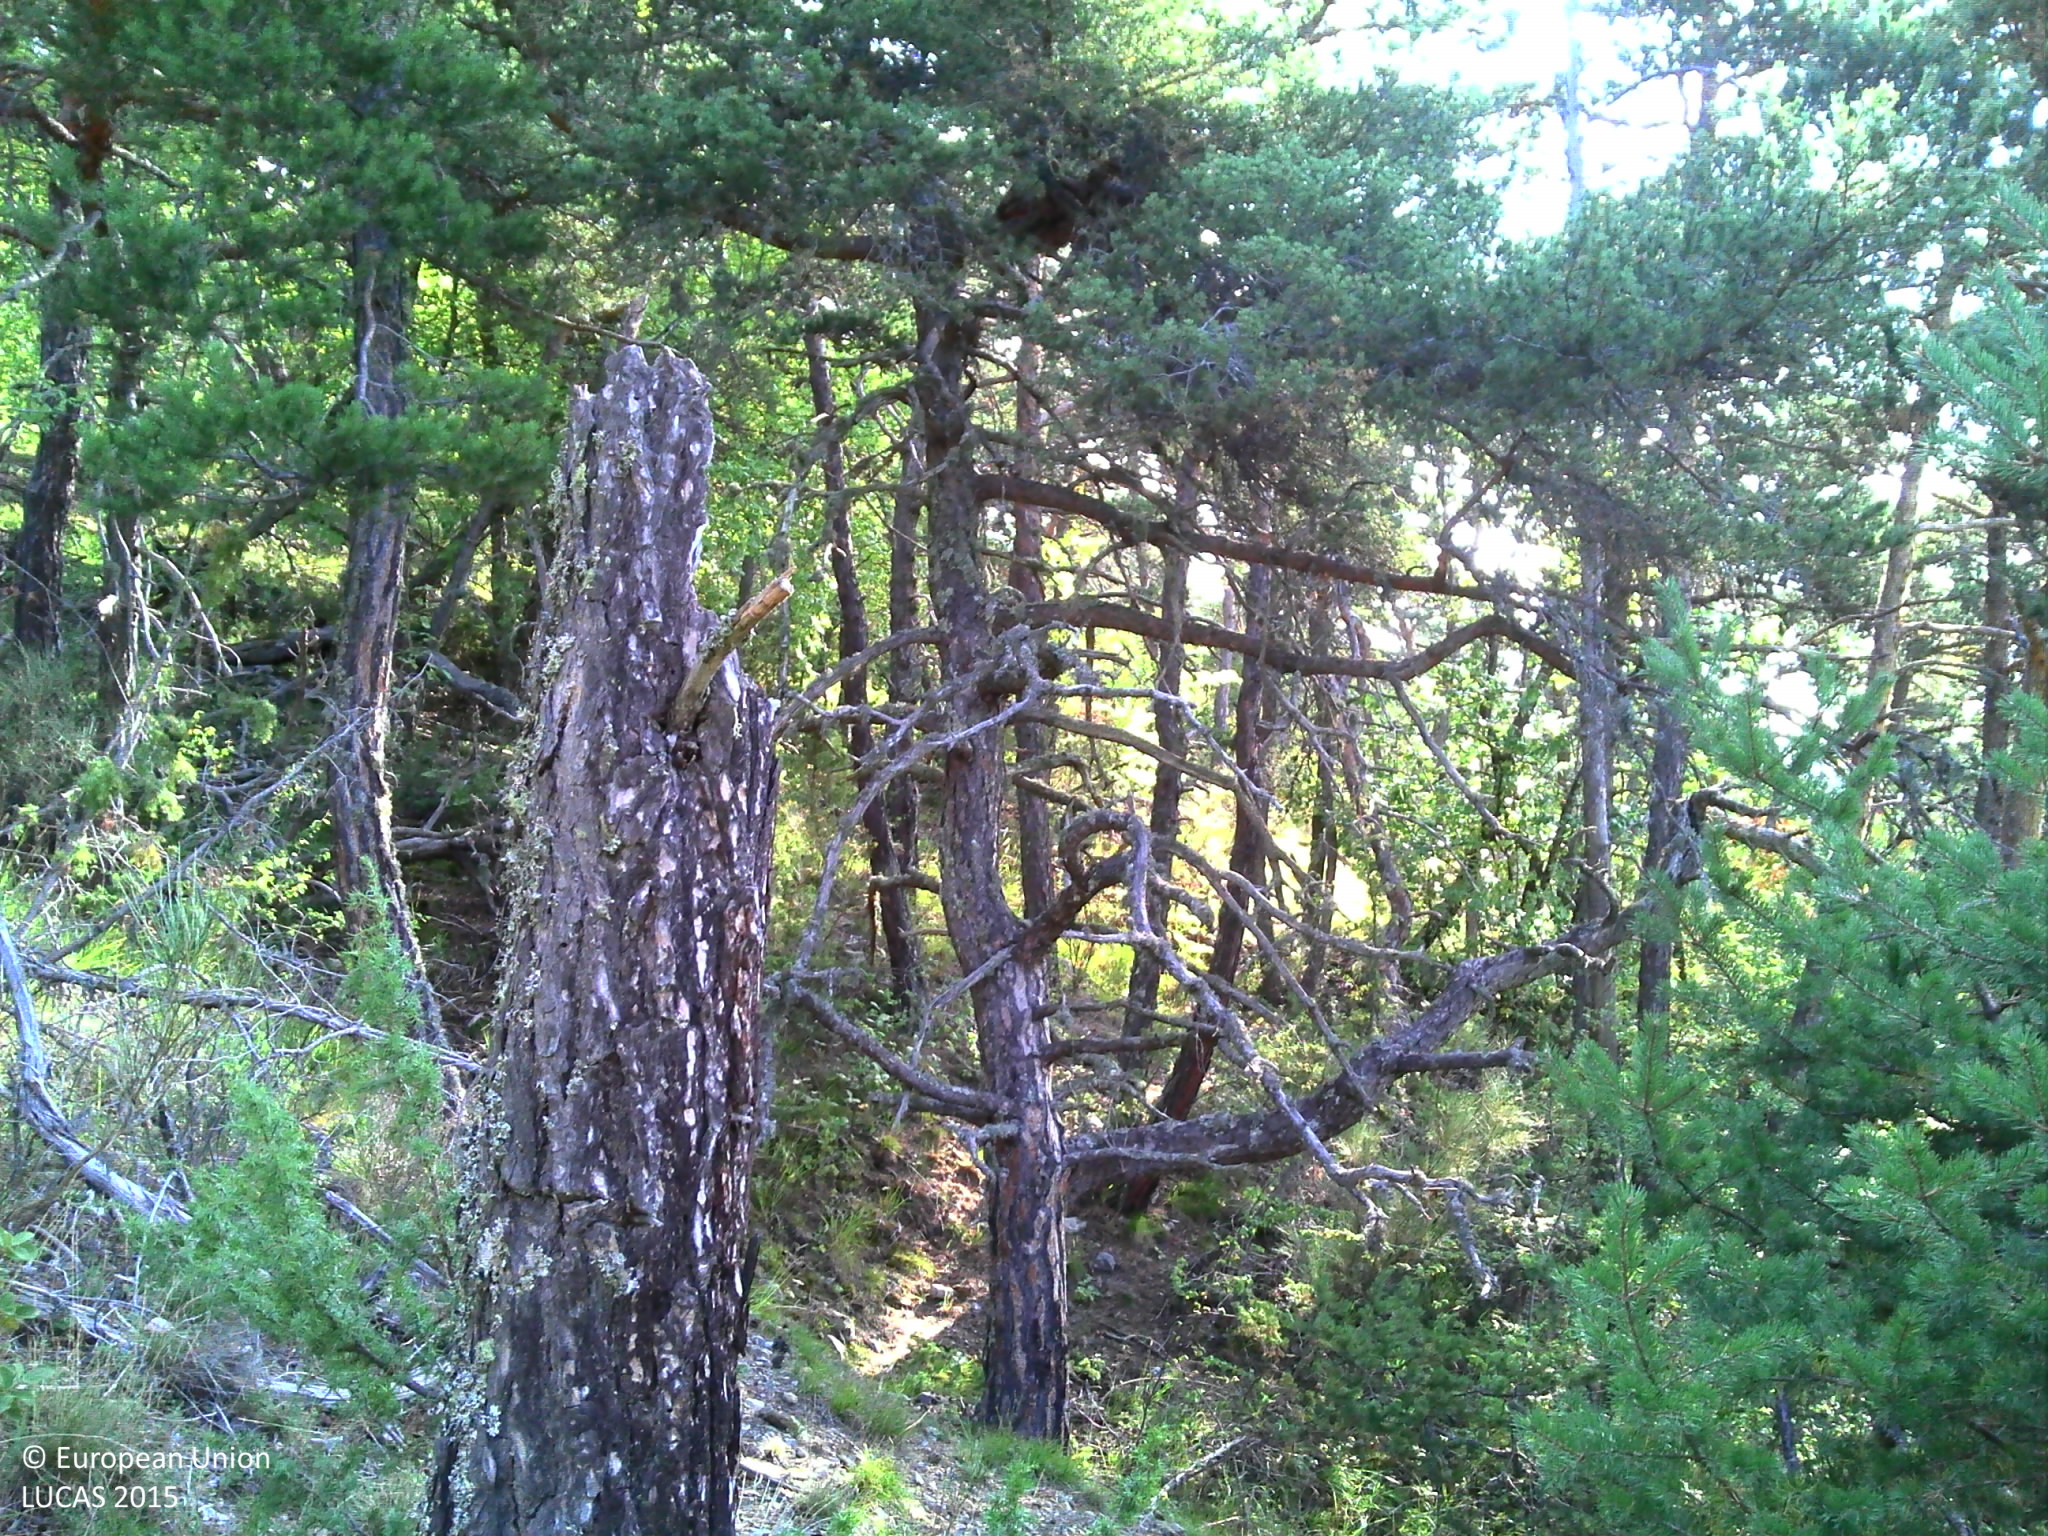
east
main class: Woodland
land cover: Pine dominated coniferous woodland
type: alpine coniferous forest
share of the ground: > 75 %
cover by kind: coniferous forest trees 50 %, herbaceous plants 20 %, broadleaved forest trees 10 %, shrubs 10 %, unconsolidated bare surface 10 %
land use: Semi-natural and natural areas not in use
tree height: > 5 m
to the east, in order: Pine dominated coniferous woodland; Pine dominated mixed woodland; Shrubland without tree cover
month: September
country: FR
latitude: 44.4084
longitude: 6.2271
